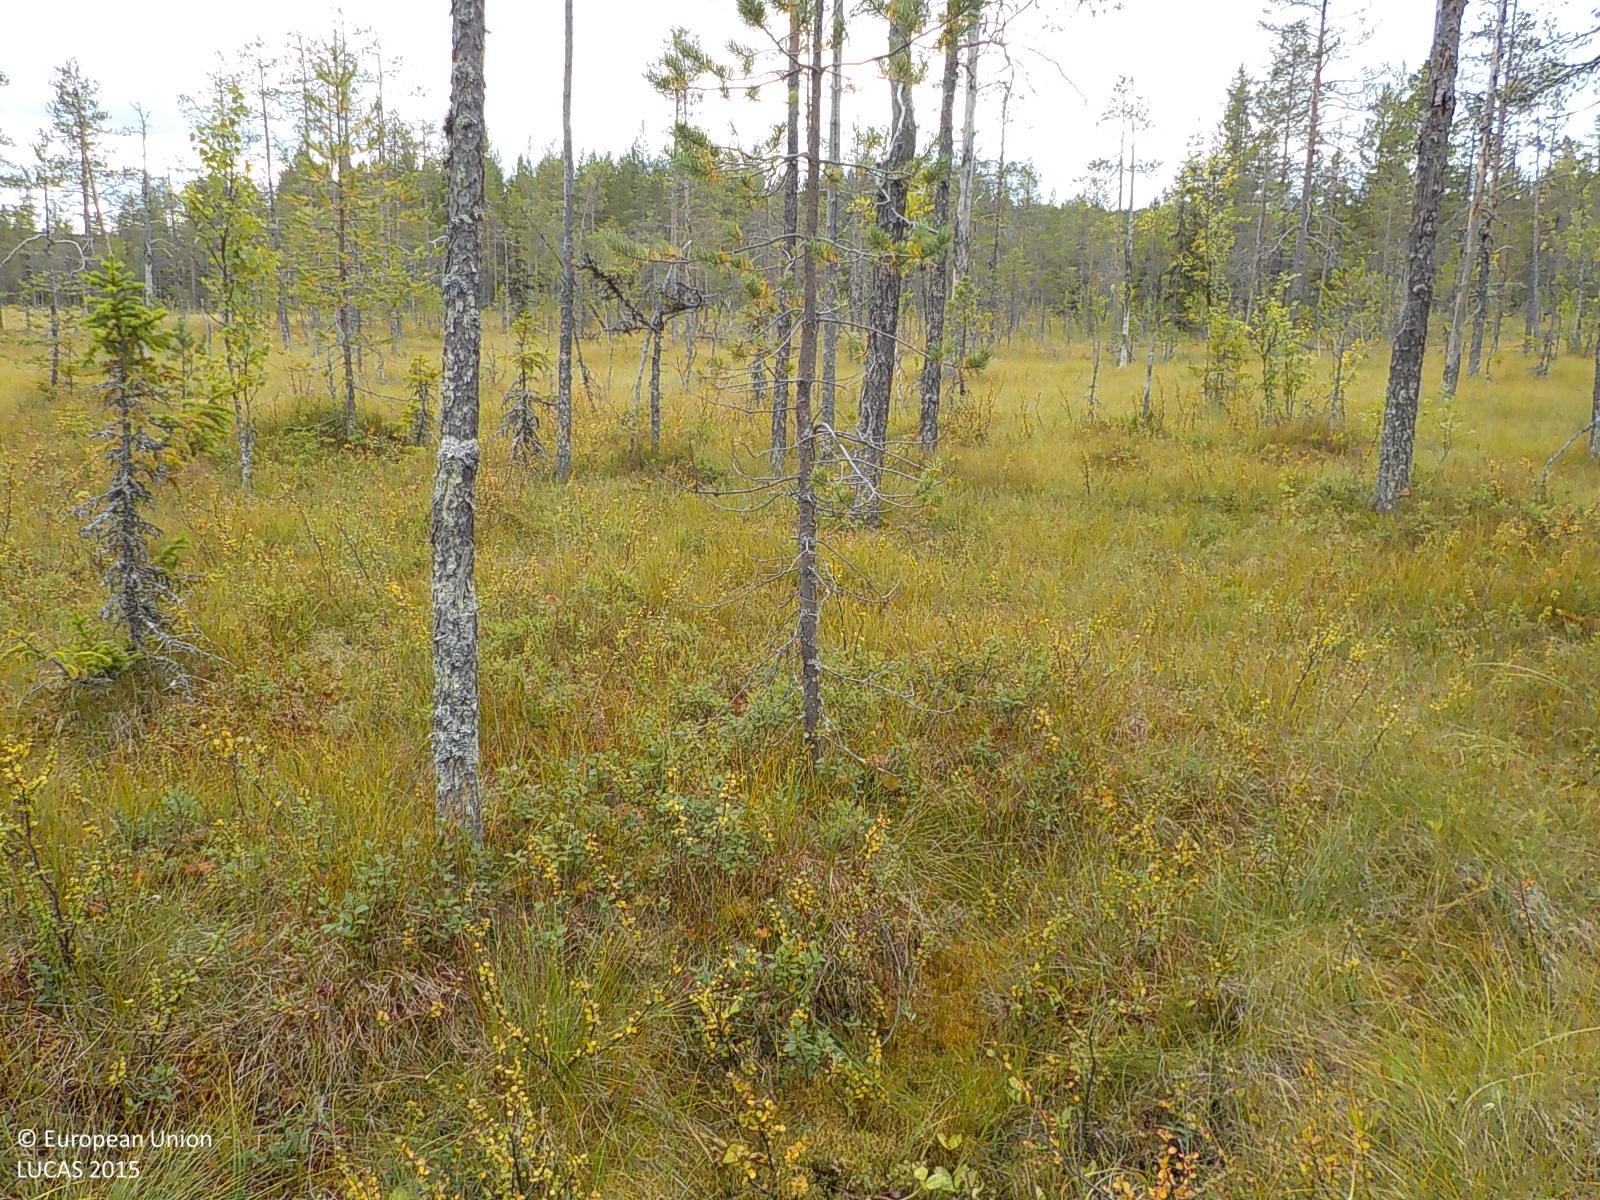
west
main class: Woodland
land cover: Pine dominated coniferous woodland
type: boreal forest
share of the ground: 10 - 25 %
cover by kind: herbaceous plants 80 %, coniferous forest trees 15 %, shrubs 5 %
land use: Semi-natural and natural areas not in use
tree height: > 5 m
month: September
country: SE
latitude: 63.3986
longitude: 17.2405
